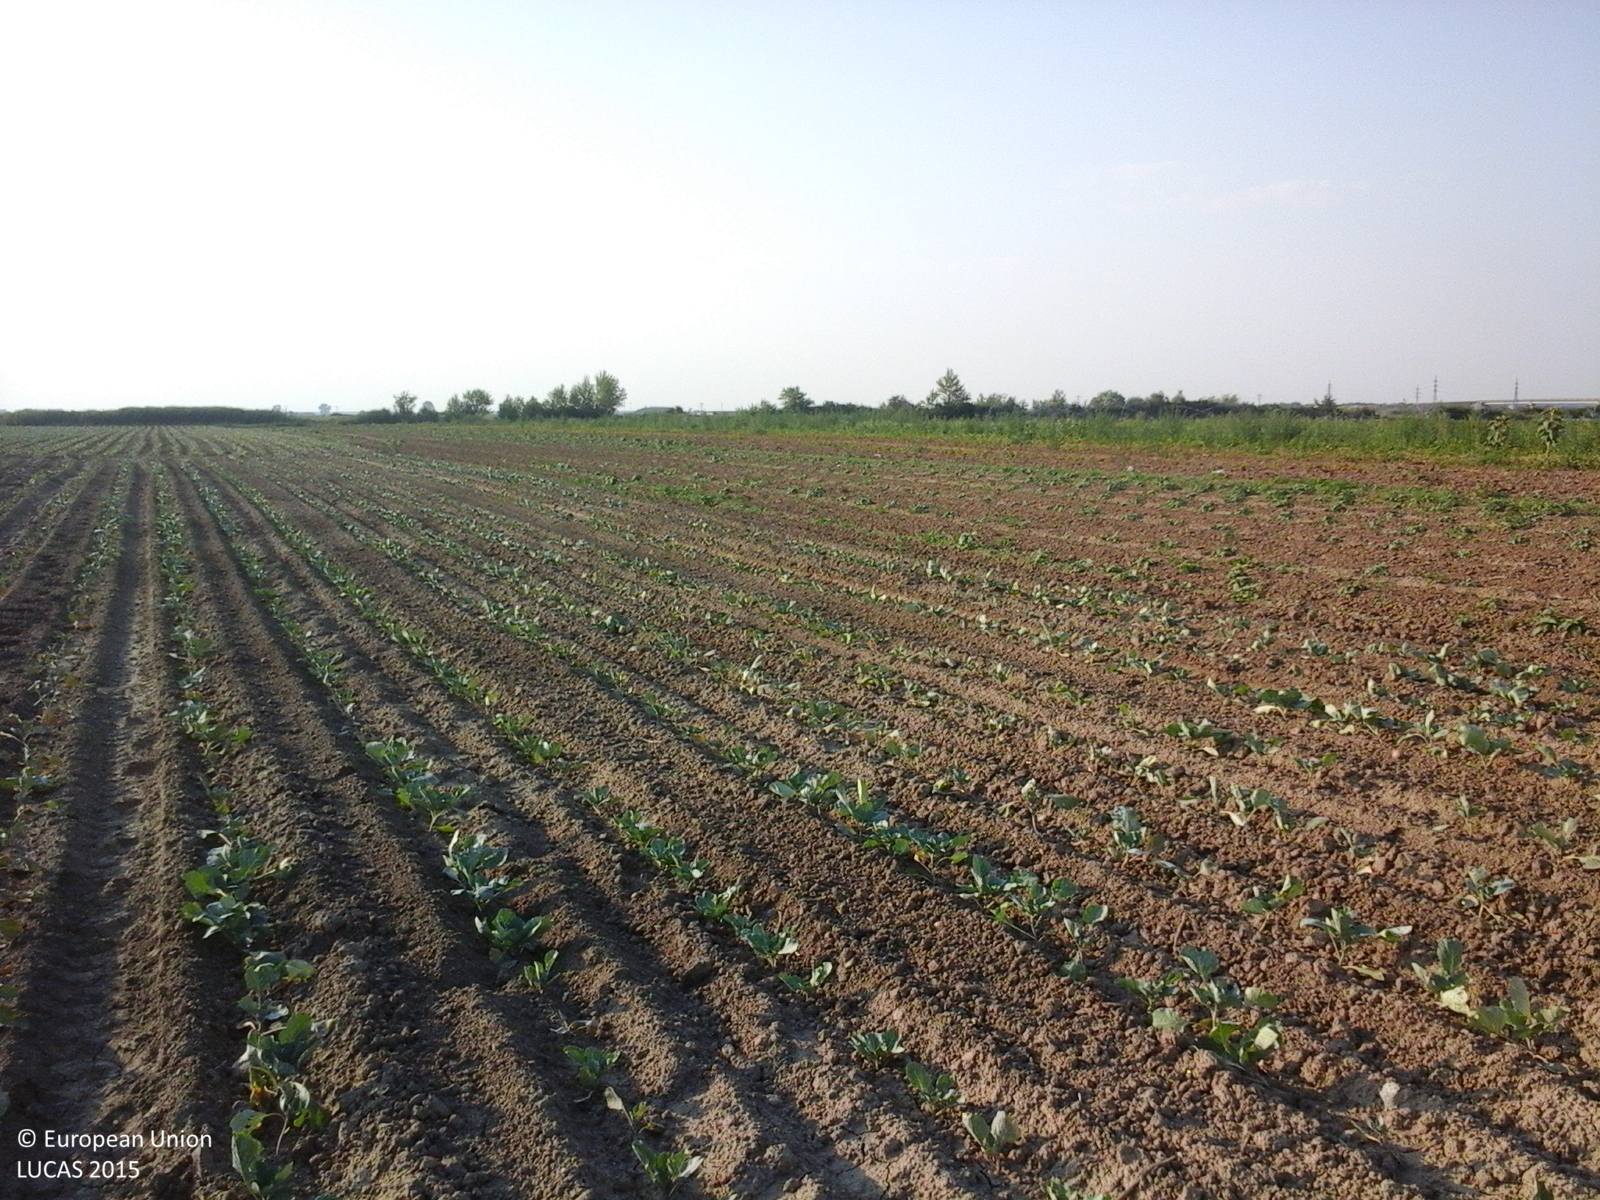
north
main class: Cropland
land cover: Other fresh vegetables
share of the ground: 10 - 25 %
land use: Agriculture (excluding fallow land and kitchen gardens)
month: July
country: RO
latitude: 44.6339
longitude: 25.6908
